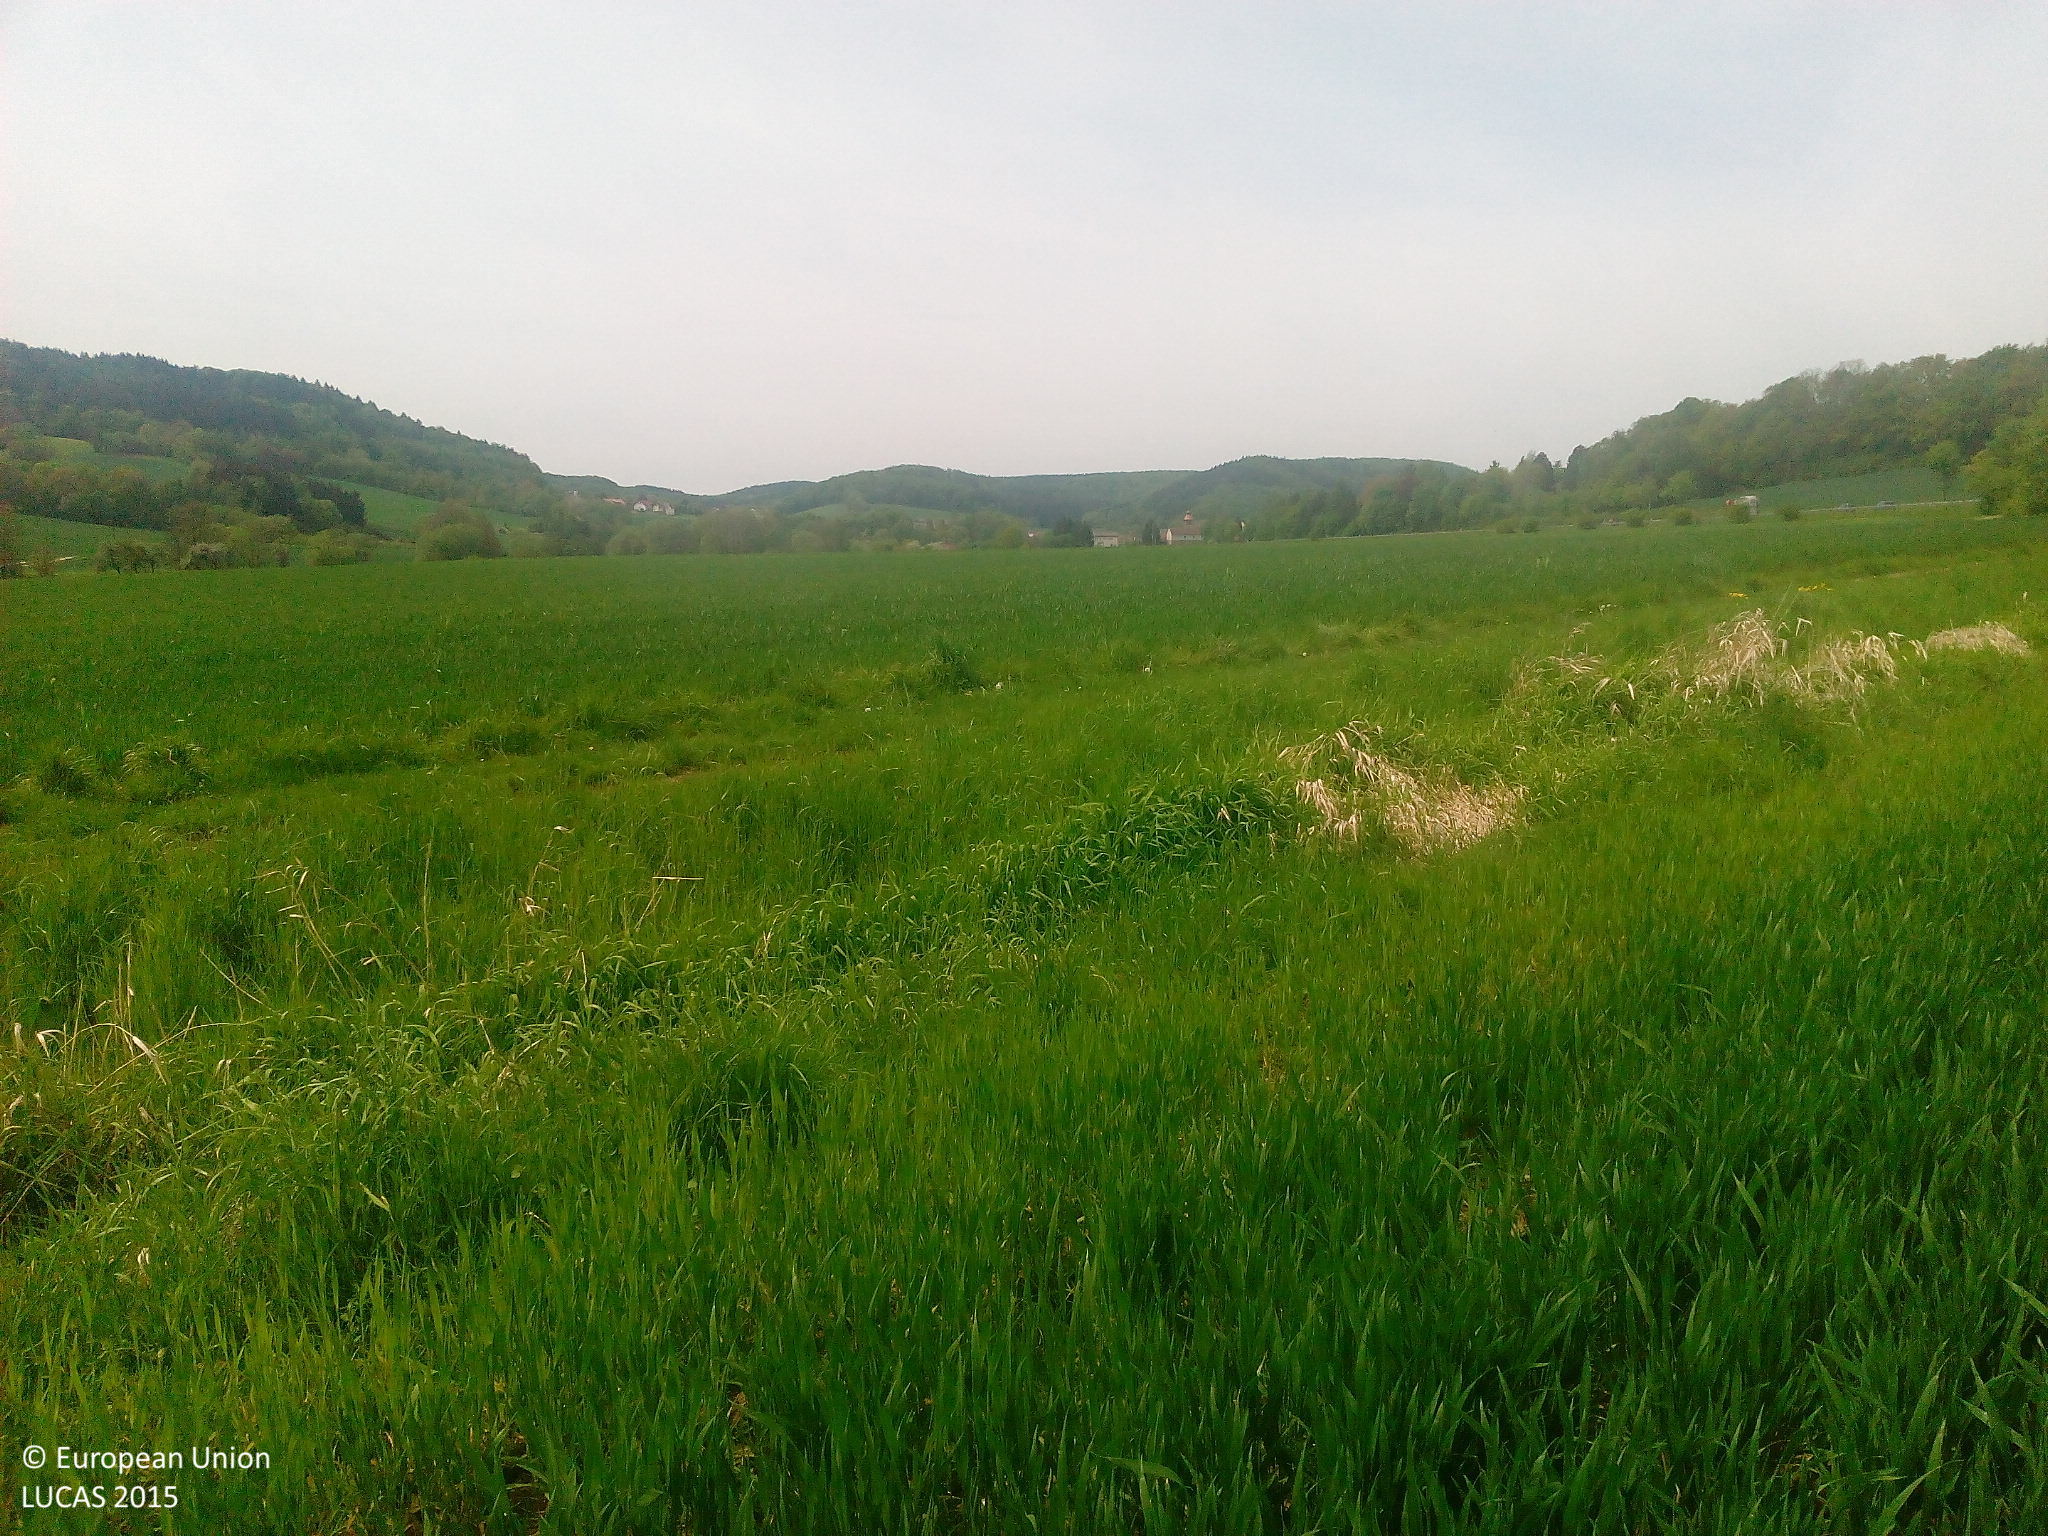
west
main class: Cropland
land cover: Common wheat
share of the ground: > 75 %
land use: Agriculture (excluding fallow land and kitchen gardens)
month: May
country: DE
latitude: 51.1371
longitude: 9.9571
